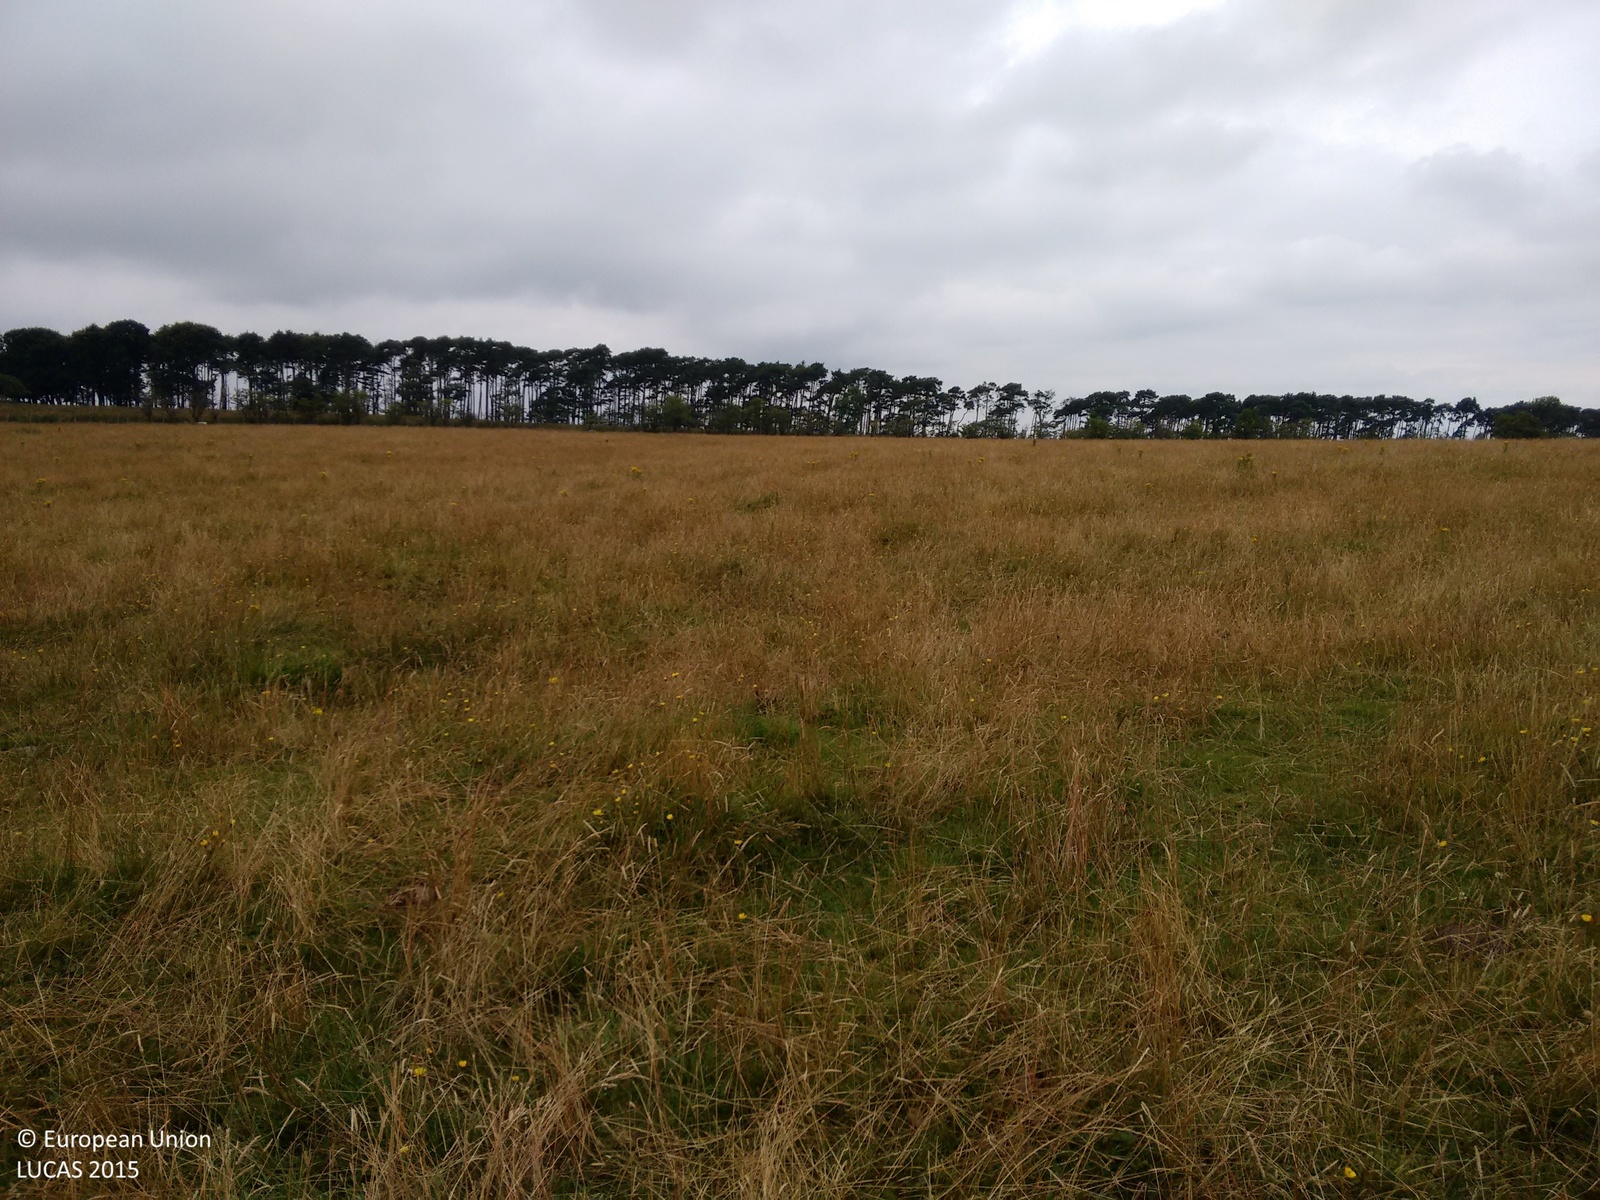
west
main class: Grassland
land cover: Grassland without tree/shrub cover
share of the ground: > 75 %
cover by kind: herbaceous plants 100 %
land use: Agriculture (excluding fallow land and kitchen gardens)
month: August
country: GB
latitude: 55.4318
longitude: -4.3355
